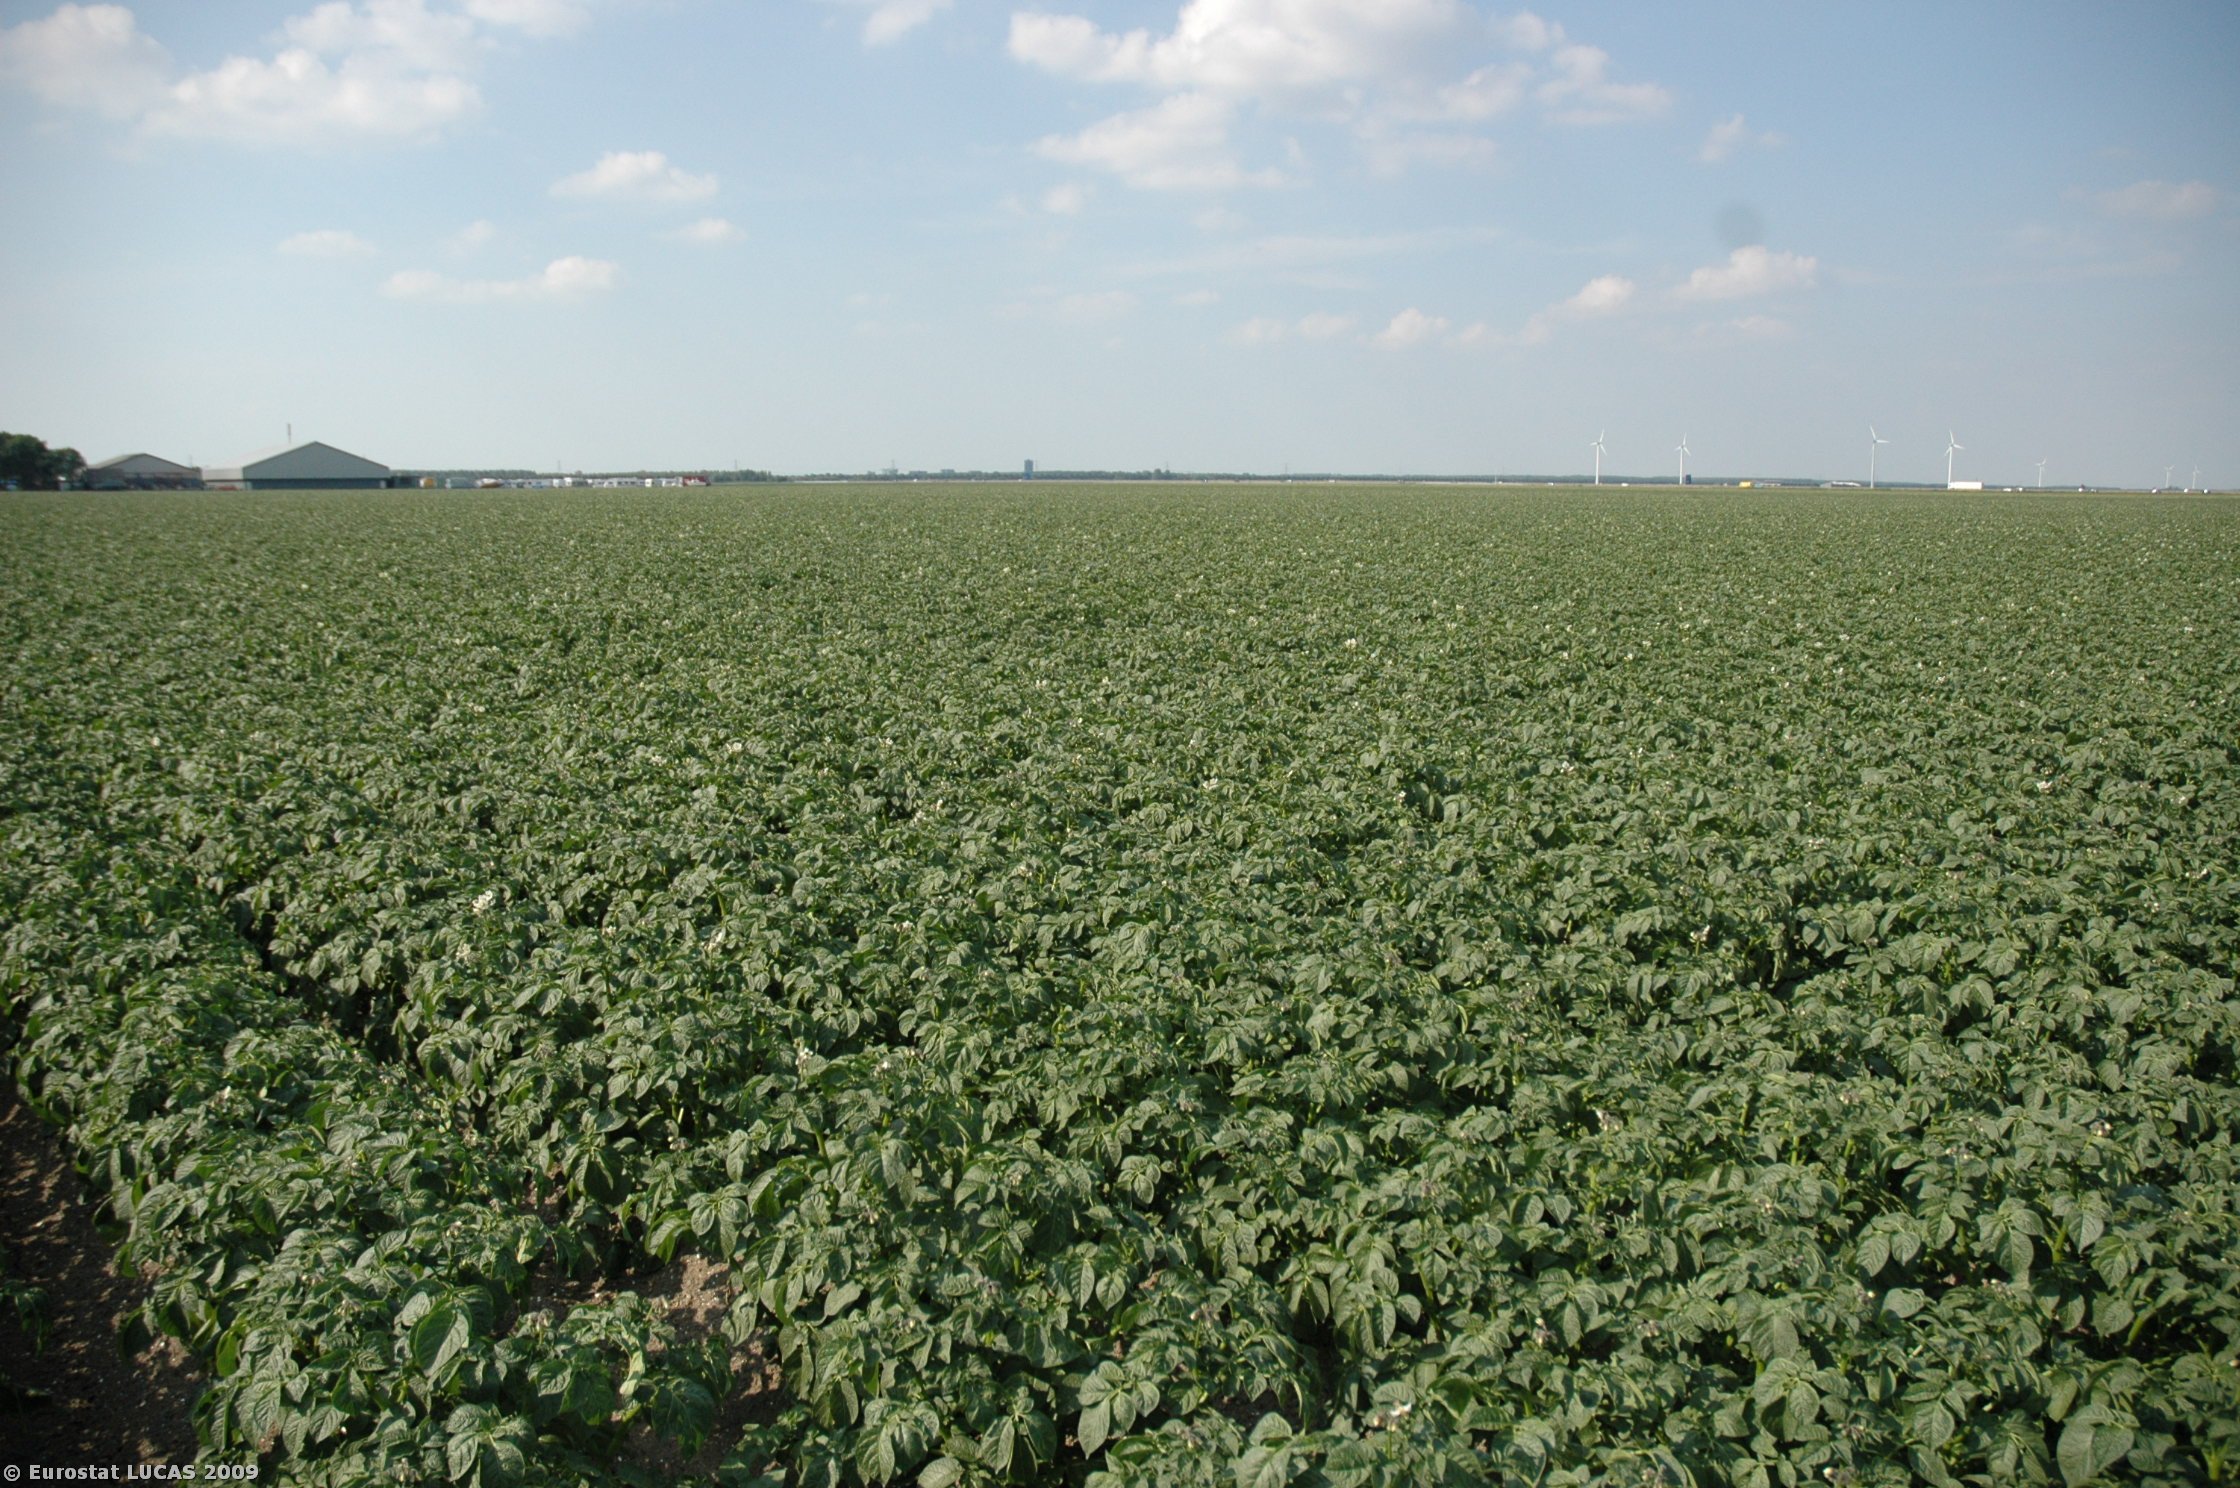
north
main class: Cropland
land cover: Potatoes
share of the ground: > 75 %
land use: Agriculture (excluding fallow land and kitchen gardens)
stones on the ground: < 10 %
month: June
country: NL
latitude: 52.3570
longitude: 5.3141
